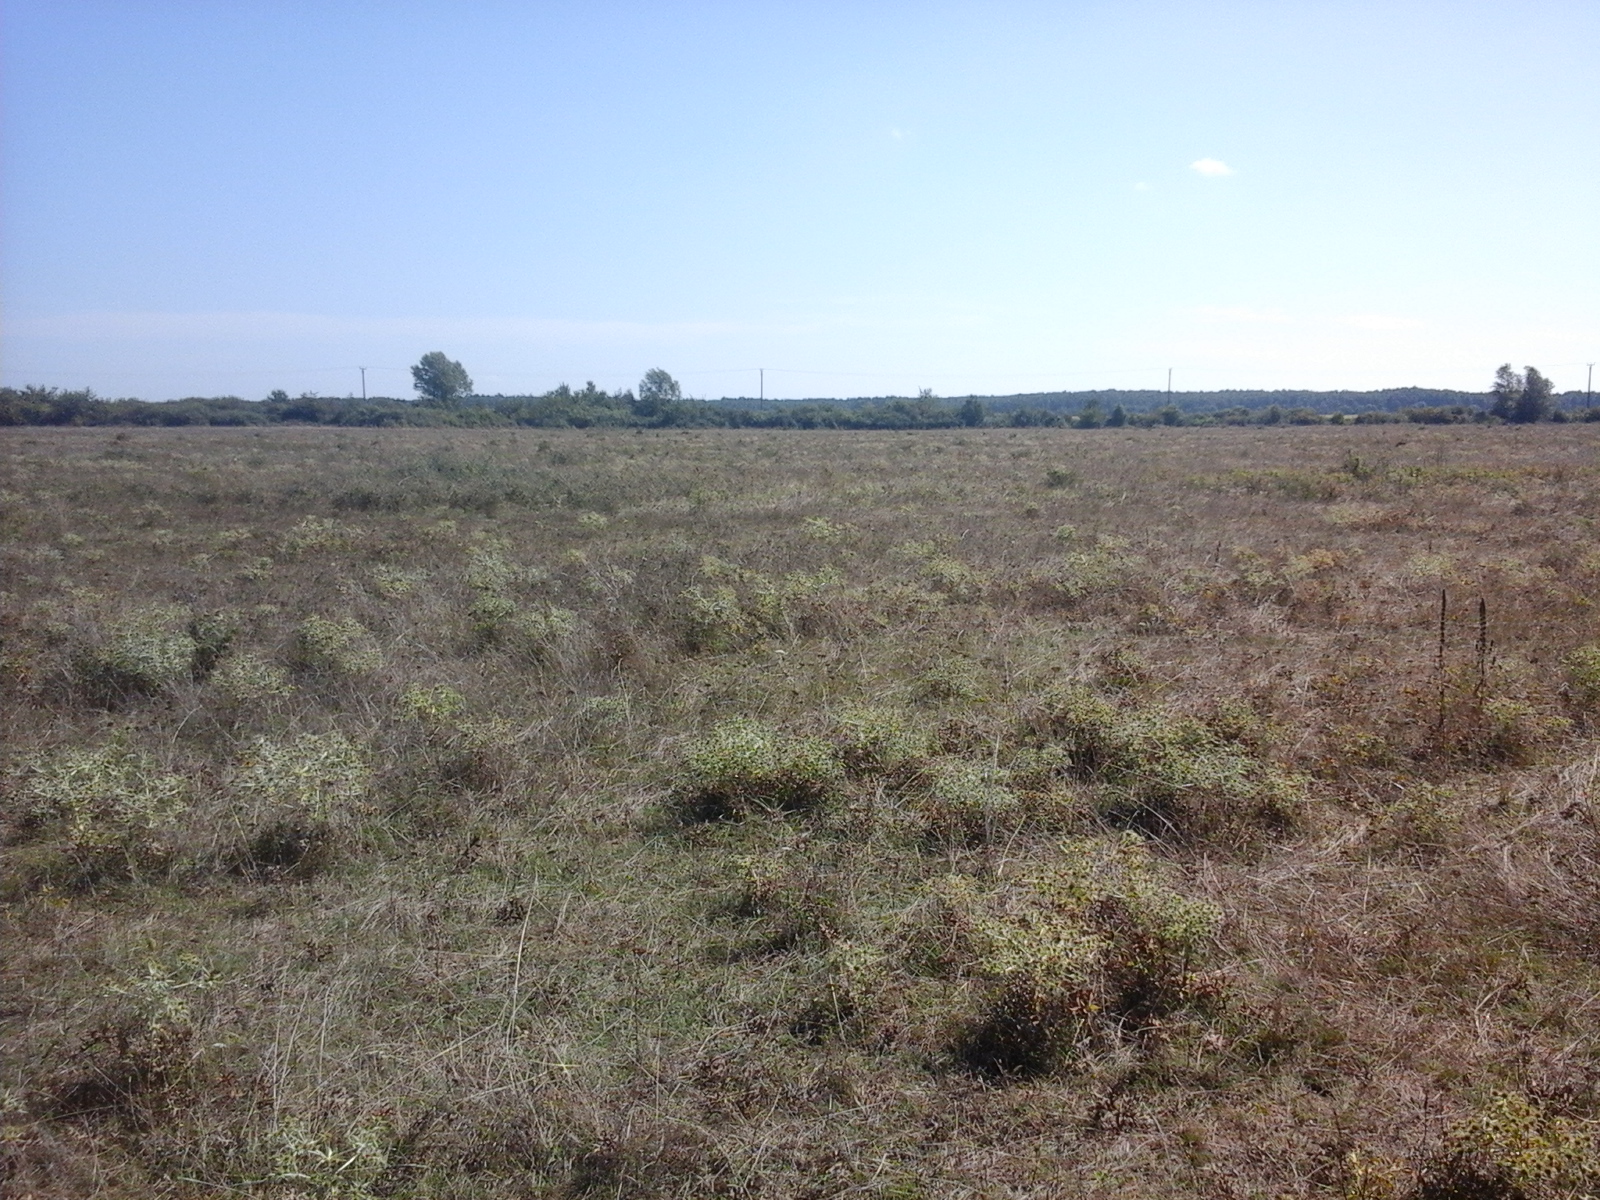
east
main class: Grassland
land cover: Spontaneously vegetated surfaces
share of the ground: > 75 %
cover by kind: herbaceous plants 100 %
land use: Fallow land
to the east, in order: Spontaneously vegetated surfaces; Tracks; Grassland without tree/shrub cover; Abandoned hedges; Ditches and canals; Abandoned hedges
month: August
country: RO
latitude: 46.1255
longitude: 21.0177
